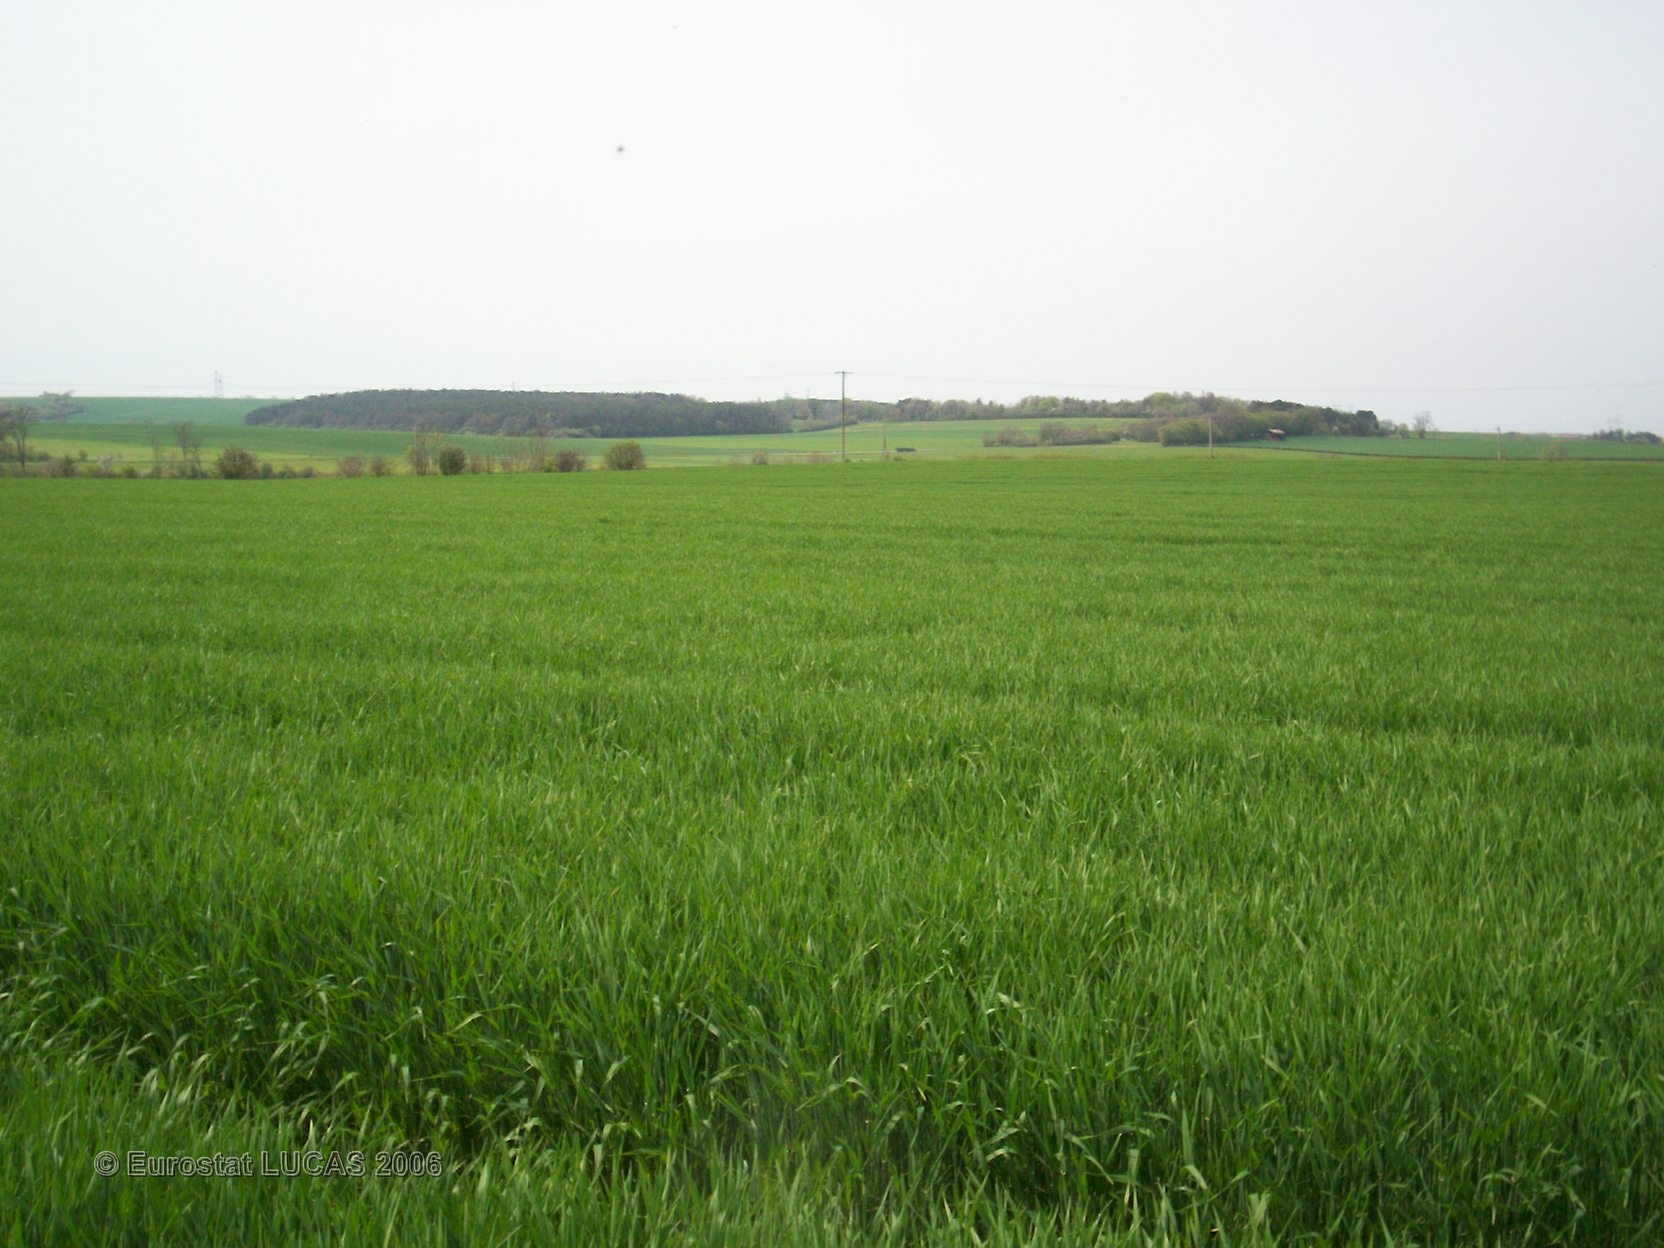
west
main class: Cropland
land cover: Barley
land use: Agriculture (excluding fallow land and kitchen gardens)
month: May
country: FR
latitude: 47.6394
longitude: 4.5816
